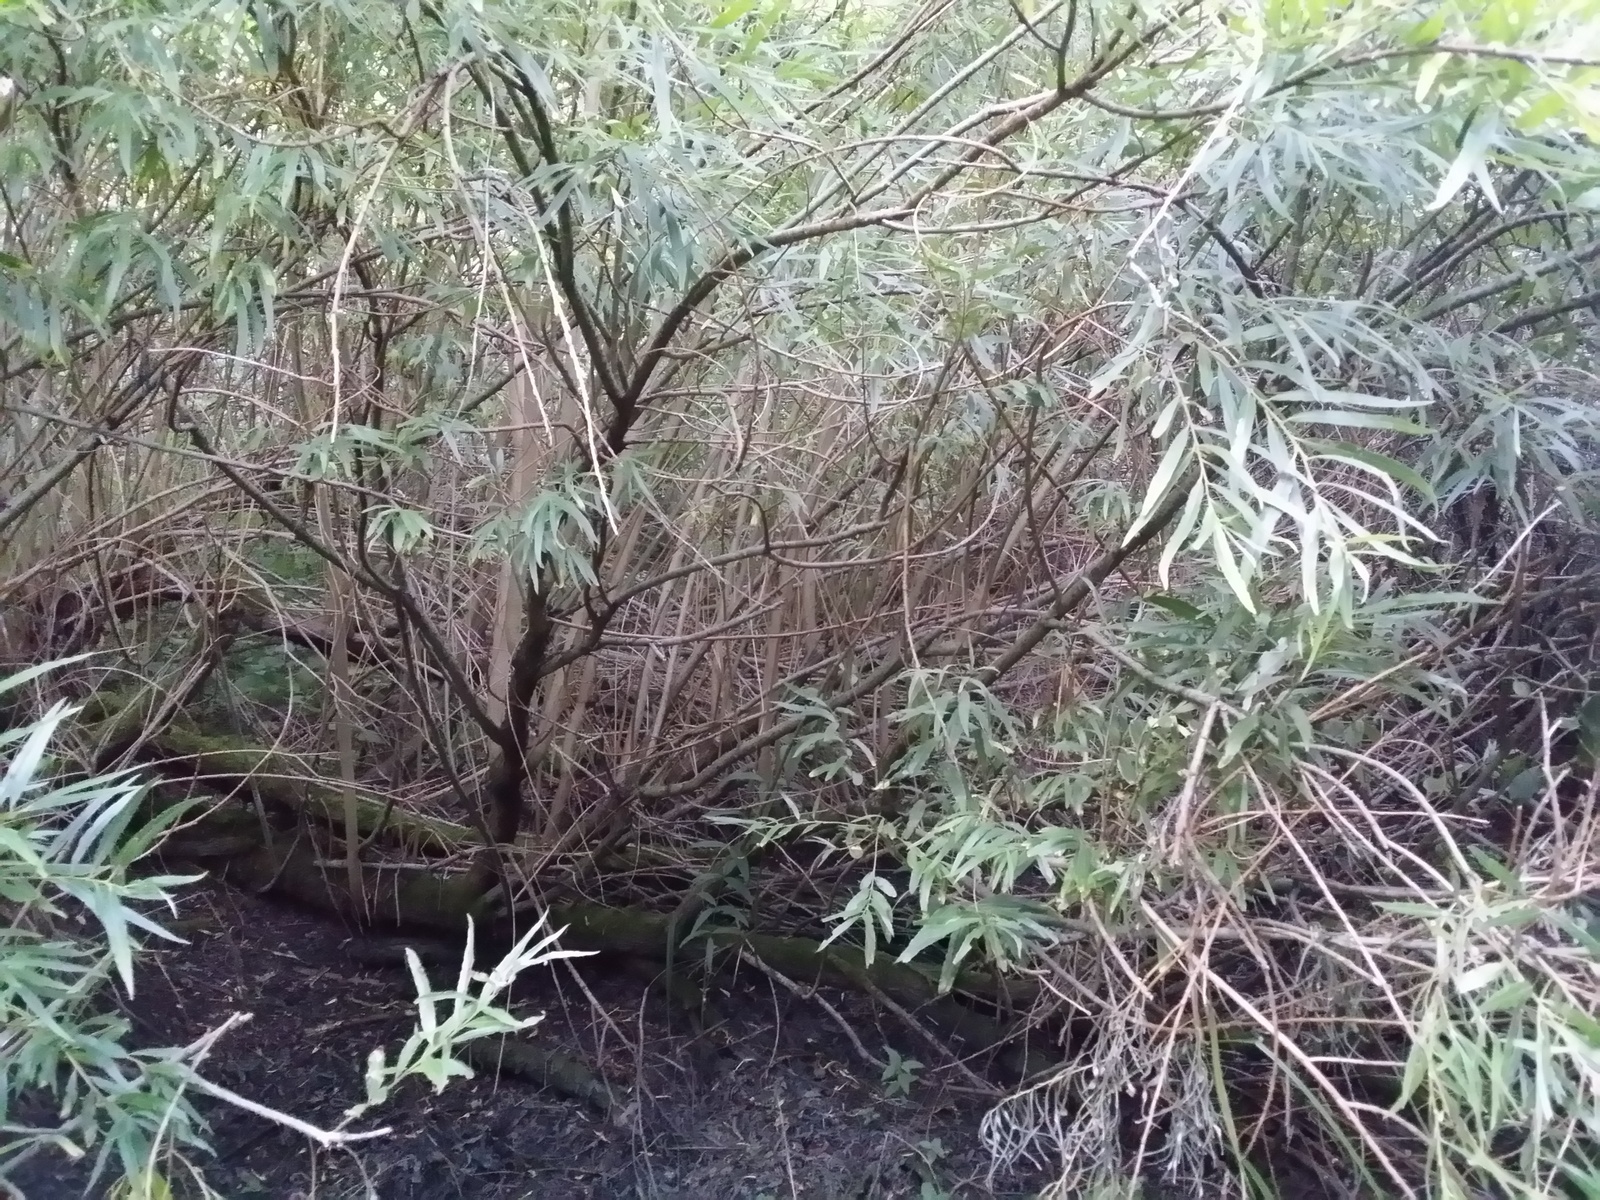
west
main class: Woodland
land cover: Broadleaved woodland
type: non-riverine alder, birch or aspen forest
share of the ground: > 75 %
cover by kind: broadleaved forest trees 90 %, shrubs 5 %, herbaceous plants 5 %
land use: Forestry
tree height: > 5 m
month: August
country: LV
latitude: 56.9215
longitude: 27.5431
